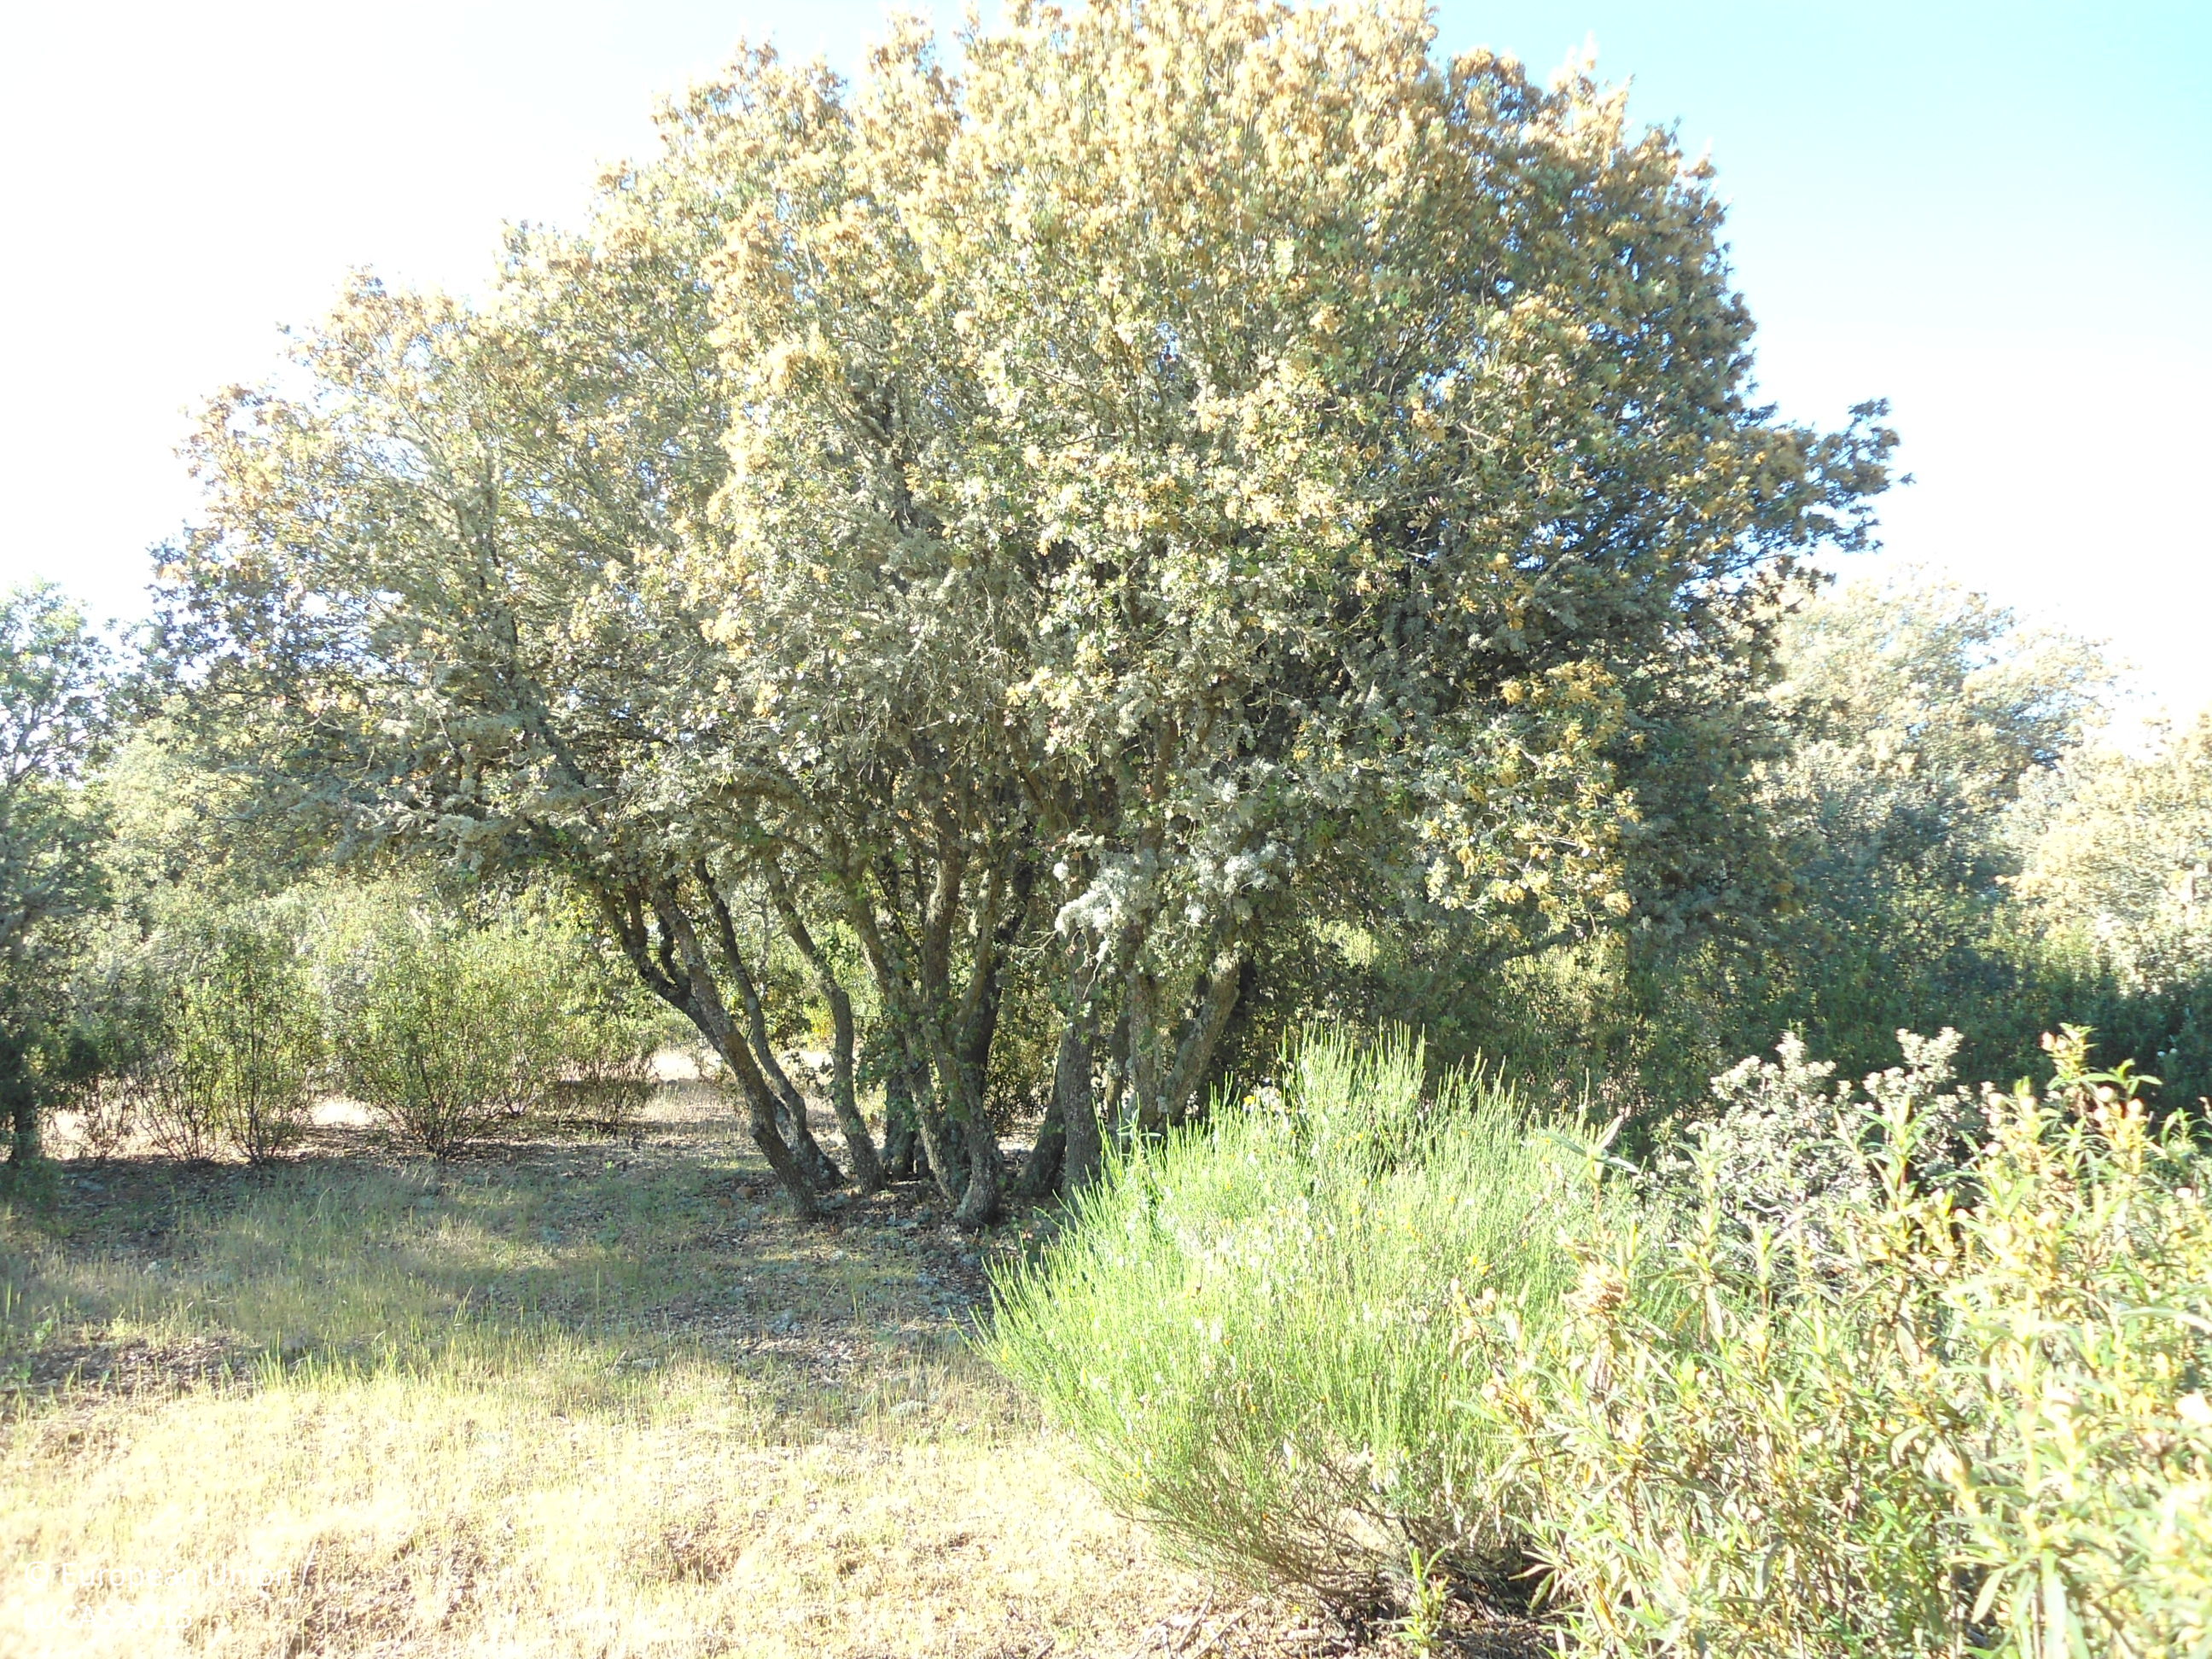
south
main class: Woodland
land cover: Broadleaved woodland
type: broadleaved evergreen forest
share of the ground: > 75 %
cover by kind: broadleaved forest trees 75 %, herbaceous plants 15 %, shrubs 10 %
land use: Forestry
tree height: > 5 m
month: May
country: ES
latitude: 42.0114
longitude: -6.0262
